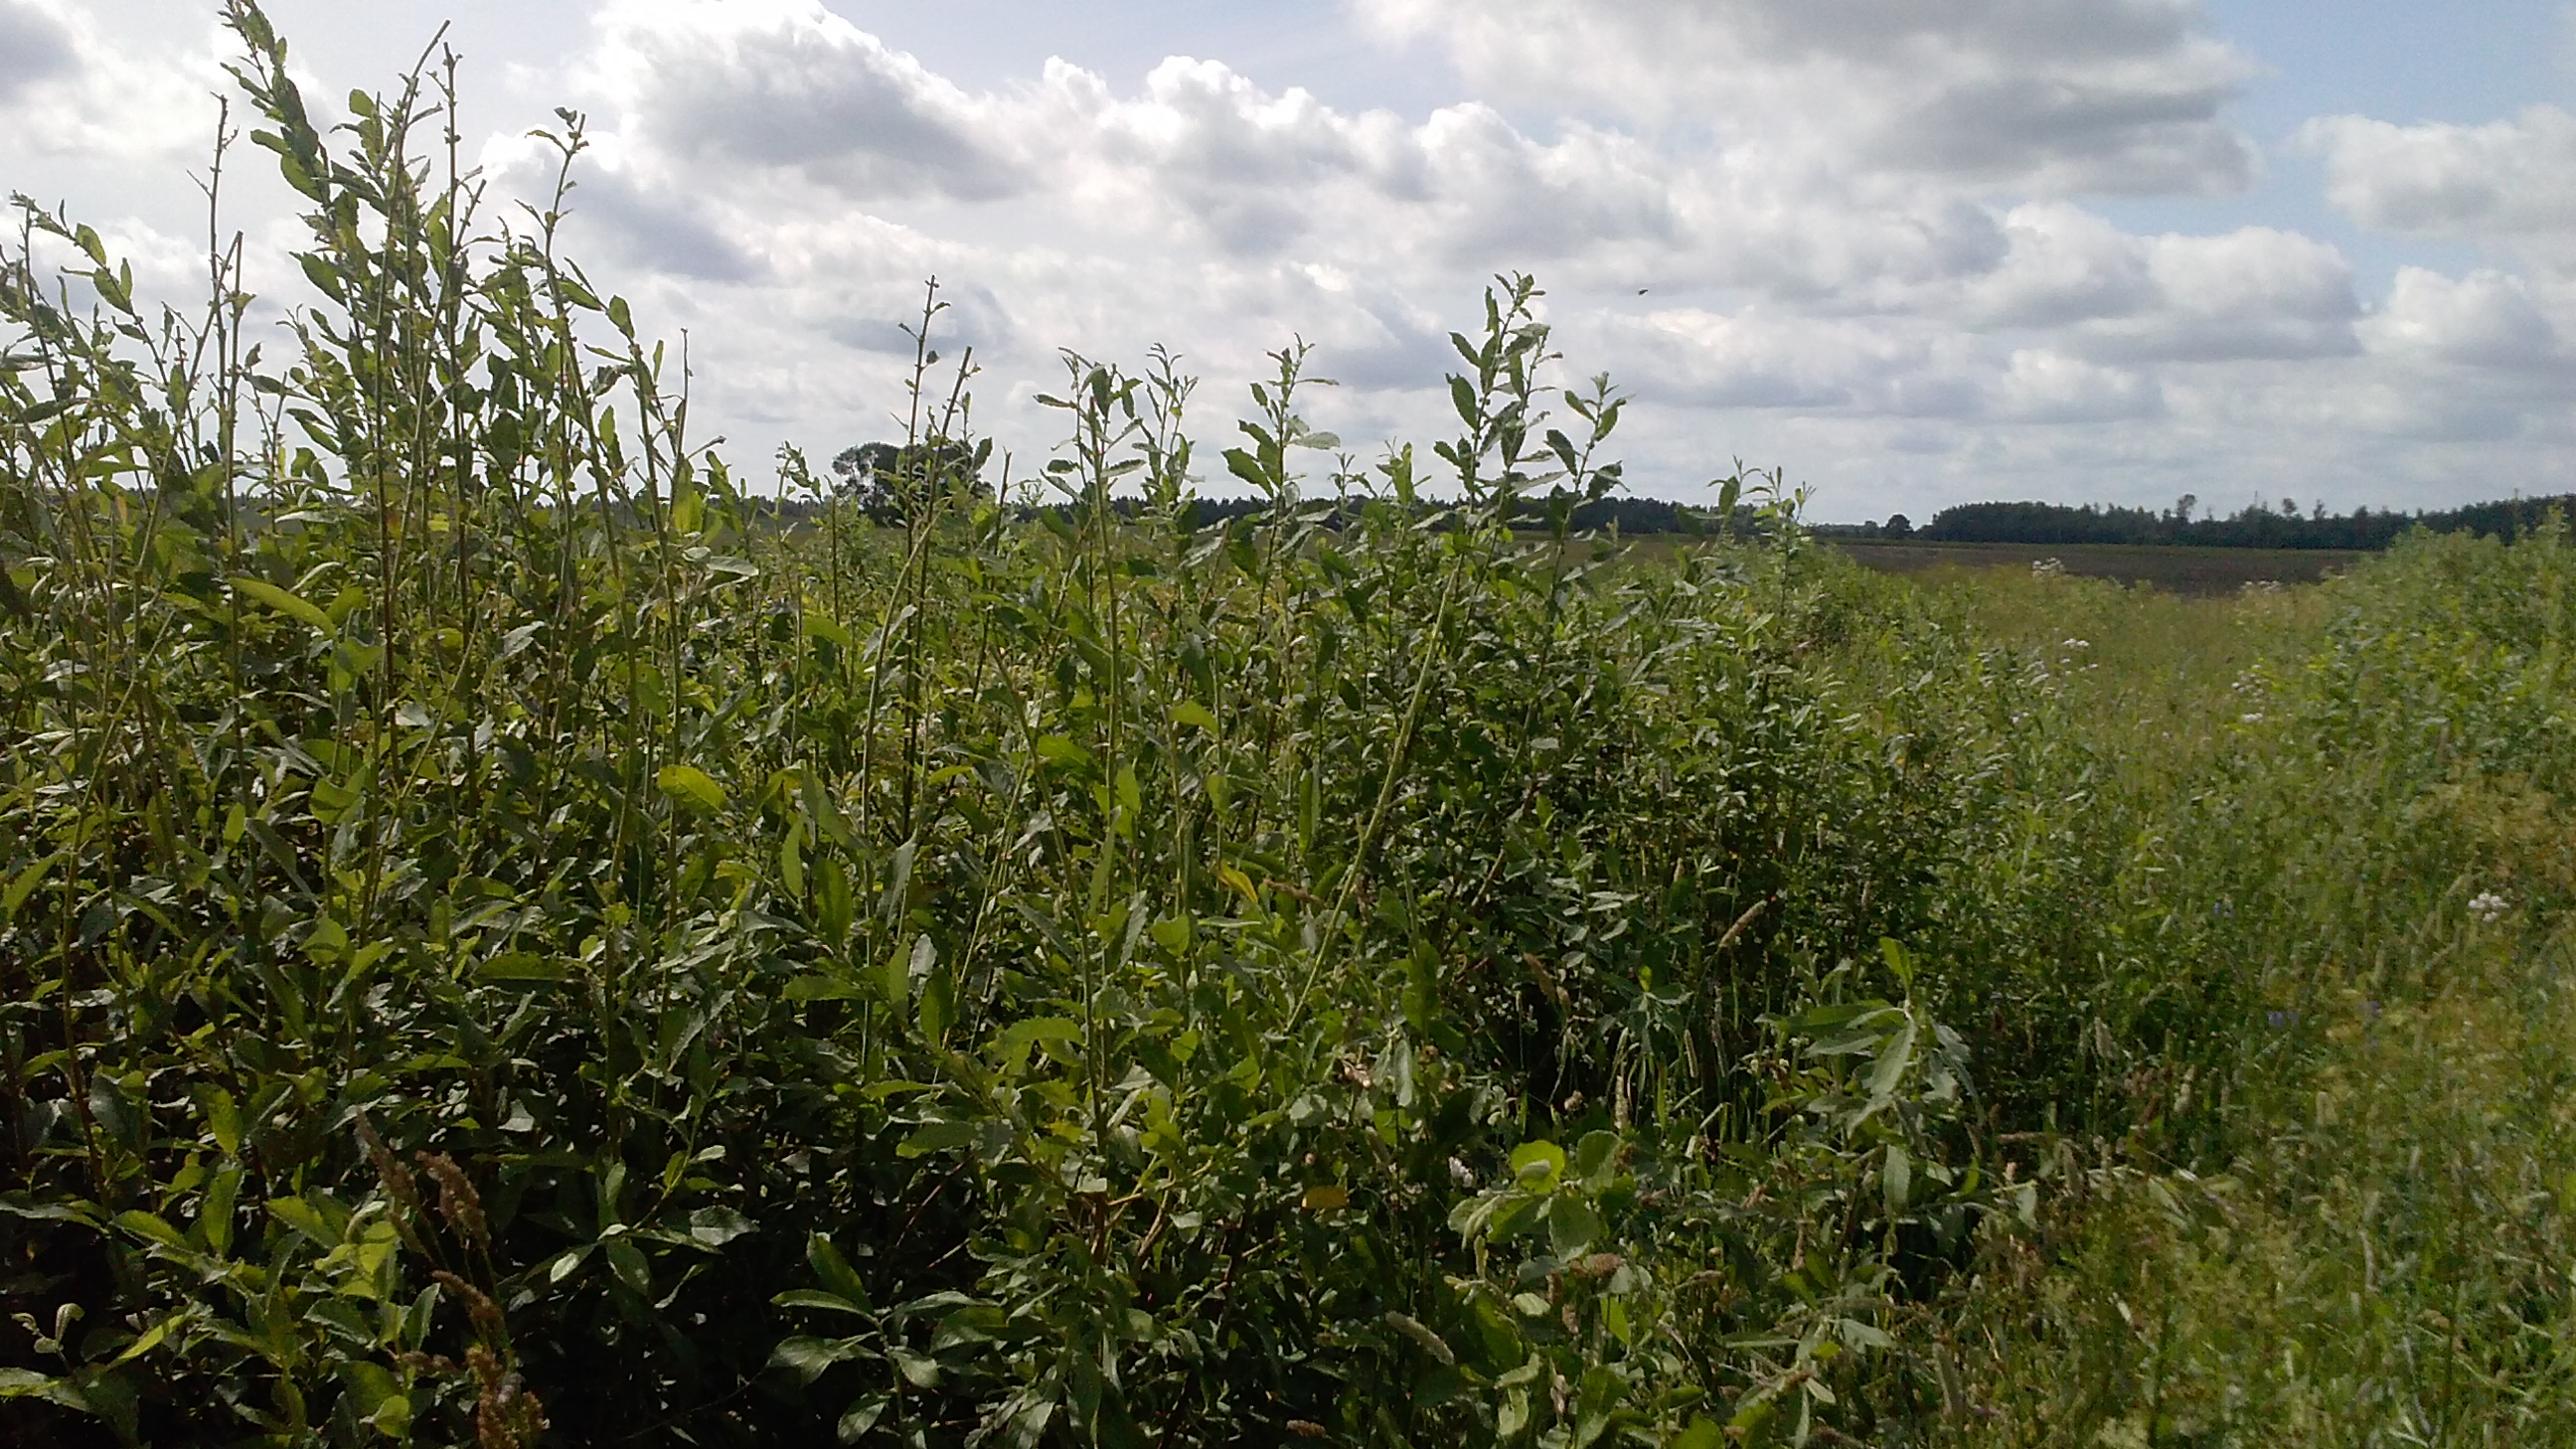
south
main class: Grassland
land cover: Grassland with sparse tree/shrub cover
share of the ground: > 75 %
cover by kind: herbaceous plants 85 %, shrubs 10 %, broadleaved forest trees 5 %
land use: Semi-natural and natural areas not in use
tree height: < 5 m
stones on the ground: < 10 %
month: July
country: LV
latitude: 56.3906
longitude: 26.8267
